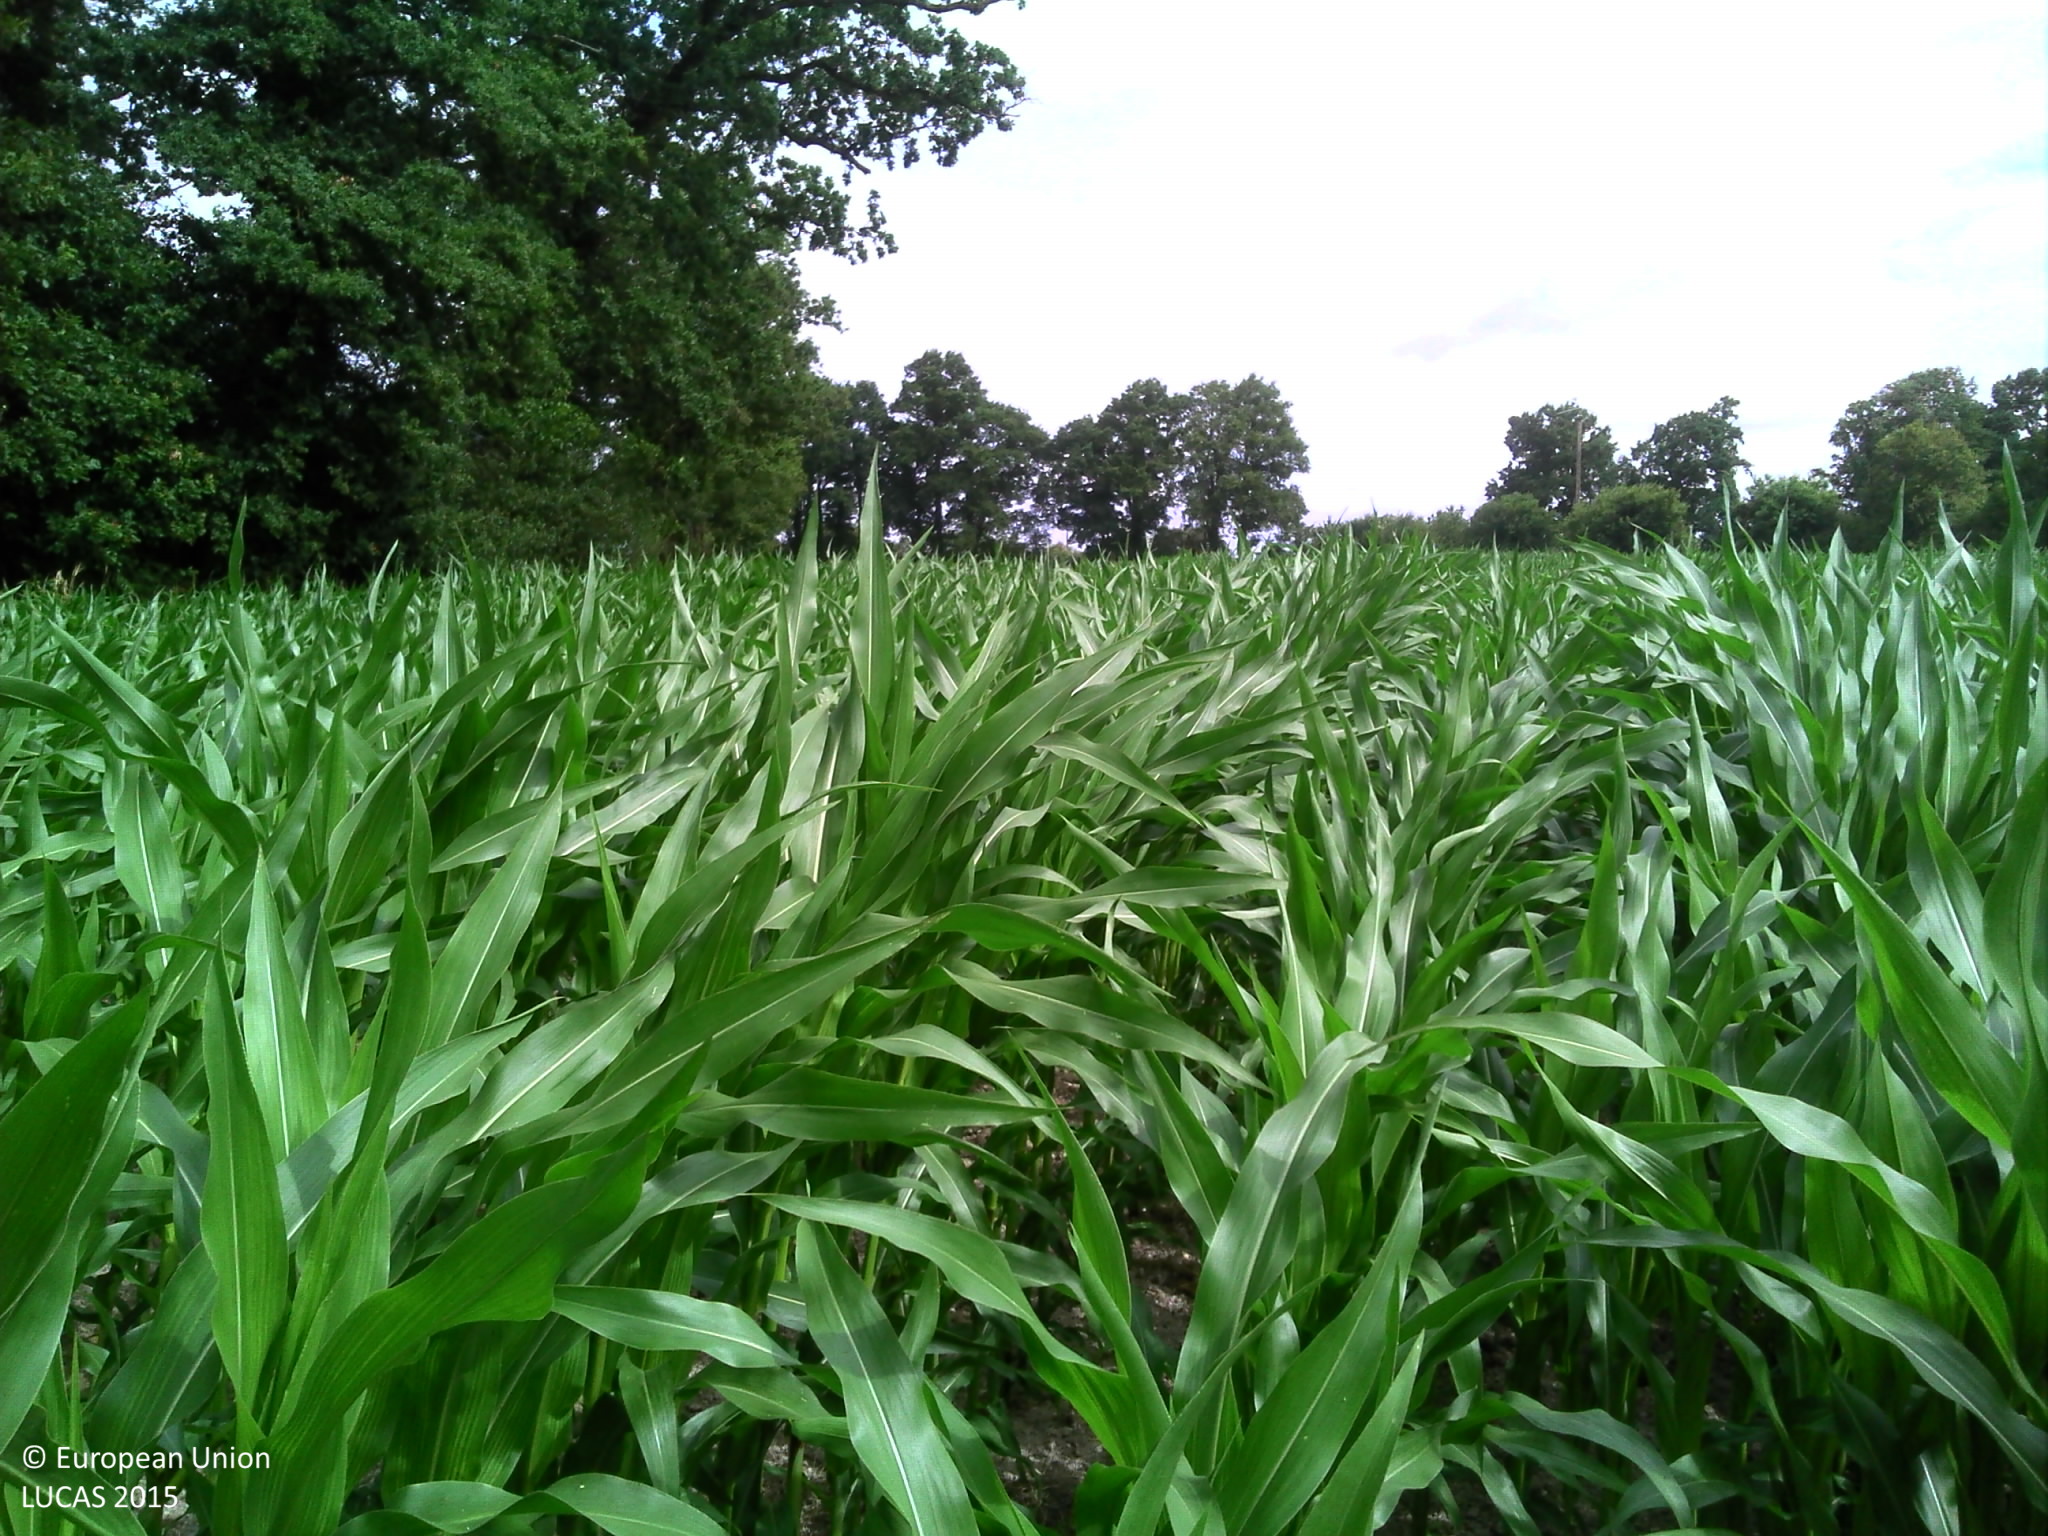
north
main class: Cropland
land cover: Maize
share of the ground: > 75 %
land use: Agriculture (excluding fallow land and kitchen gardens)
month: July
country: FR
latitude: 47.5799
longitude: -1.8677
